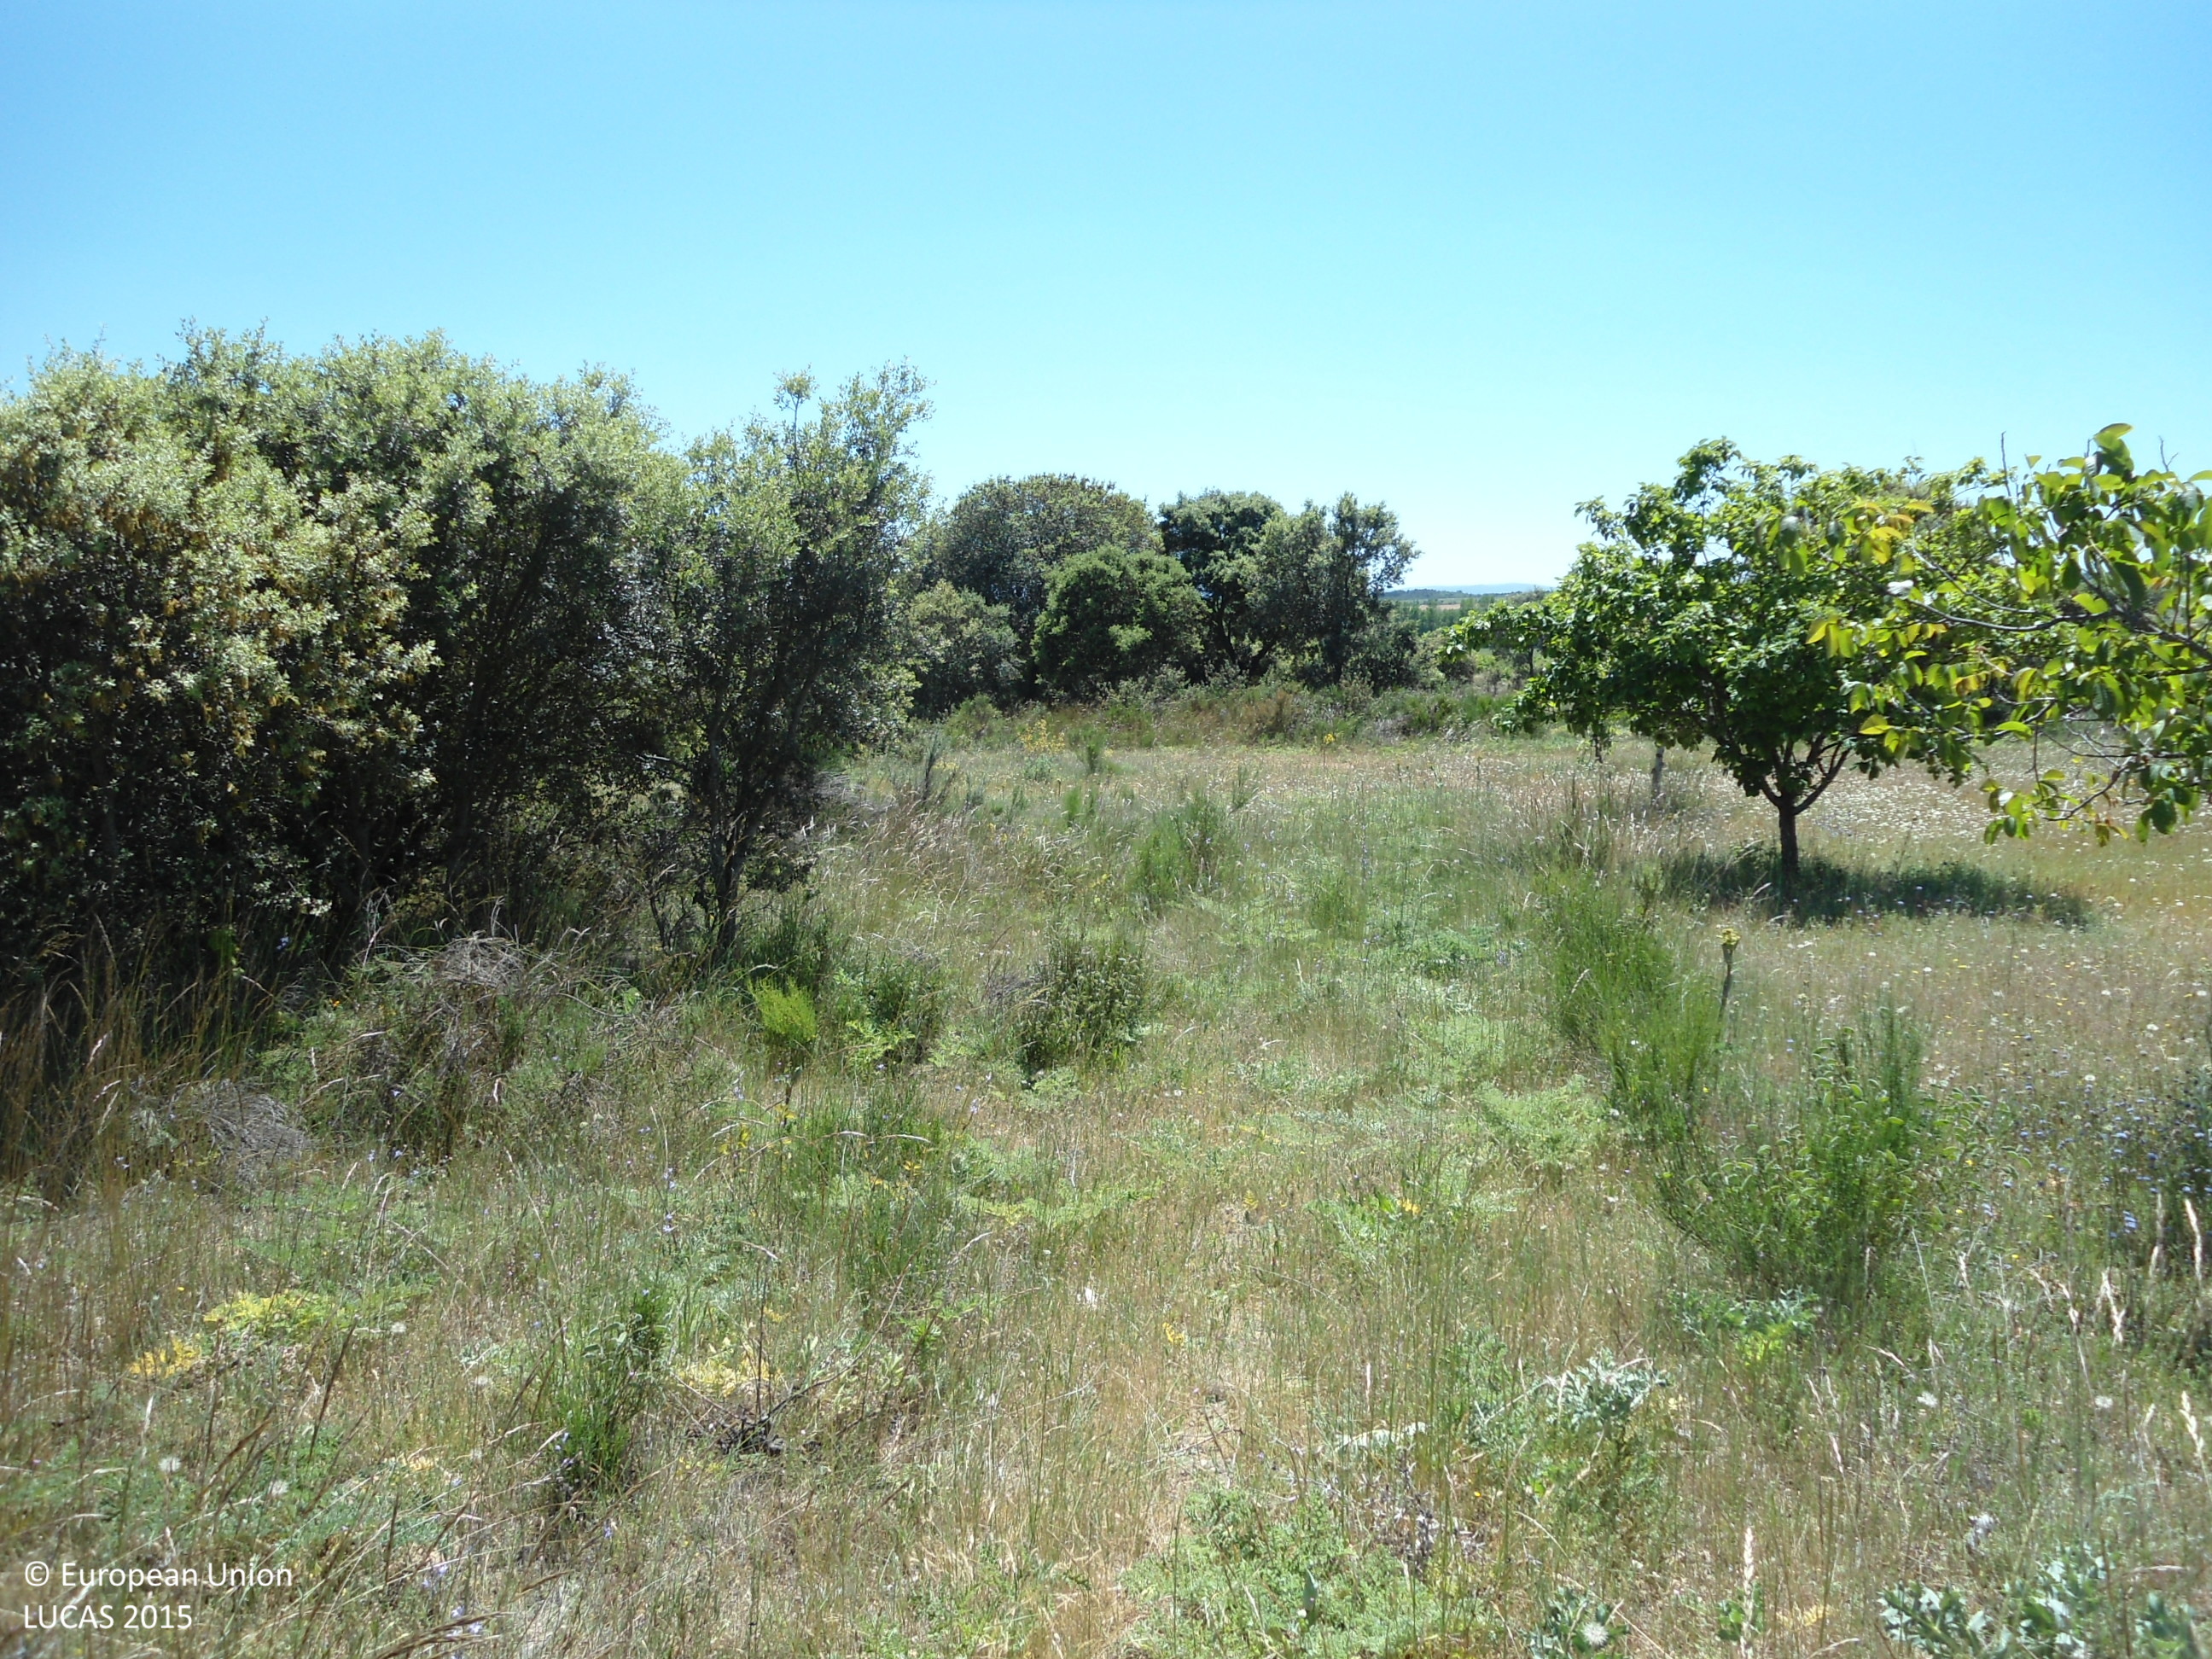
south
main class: Shrubland
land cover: Shrubland without tree cover
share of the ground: > 75 %
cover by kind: shrubs 80 %, herbaceous plants 20 %
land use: Semi-natural and natural areas not in use
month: May
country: ES
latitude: 42.1033
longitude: -6.0262
